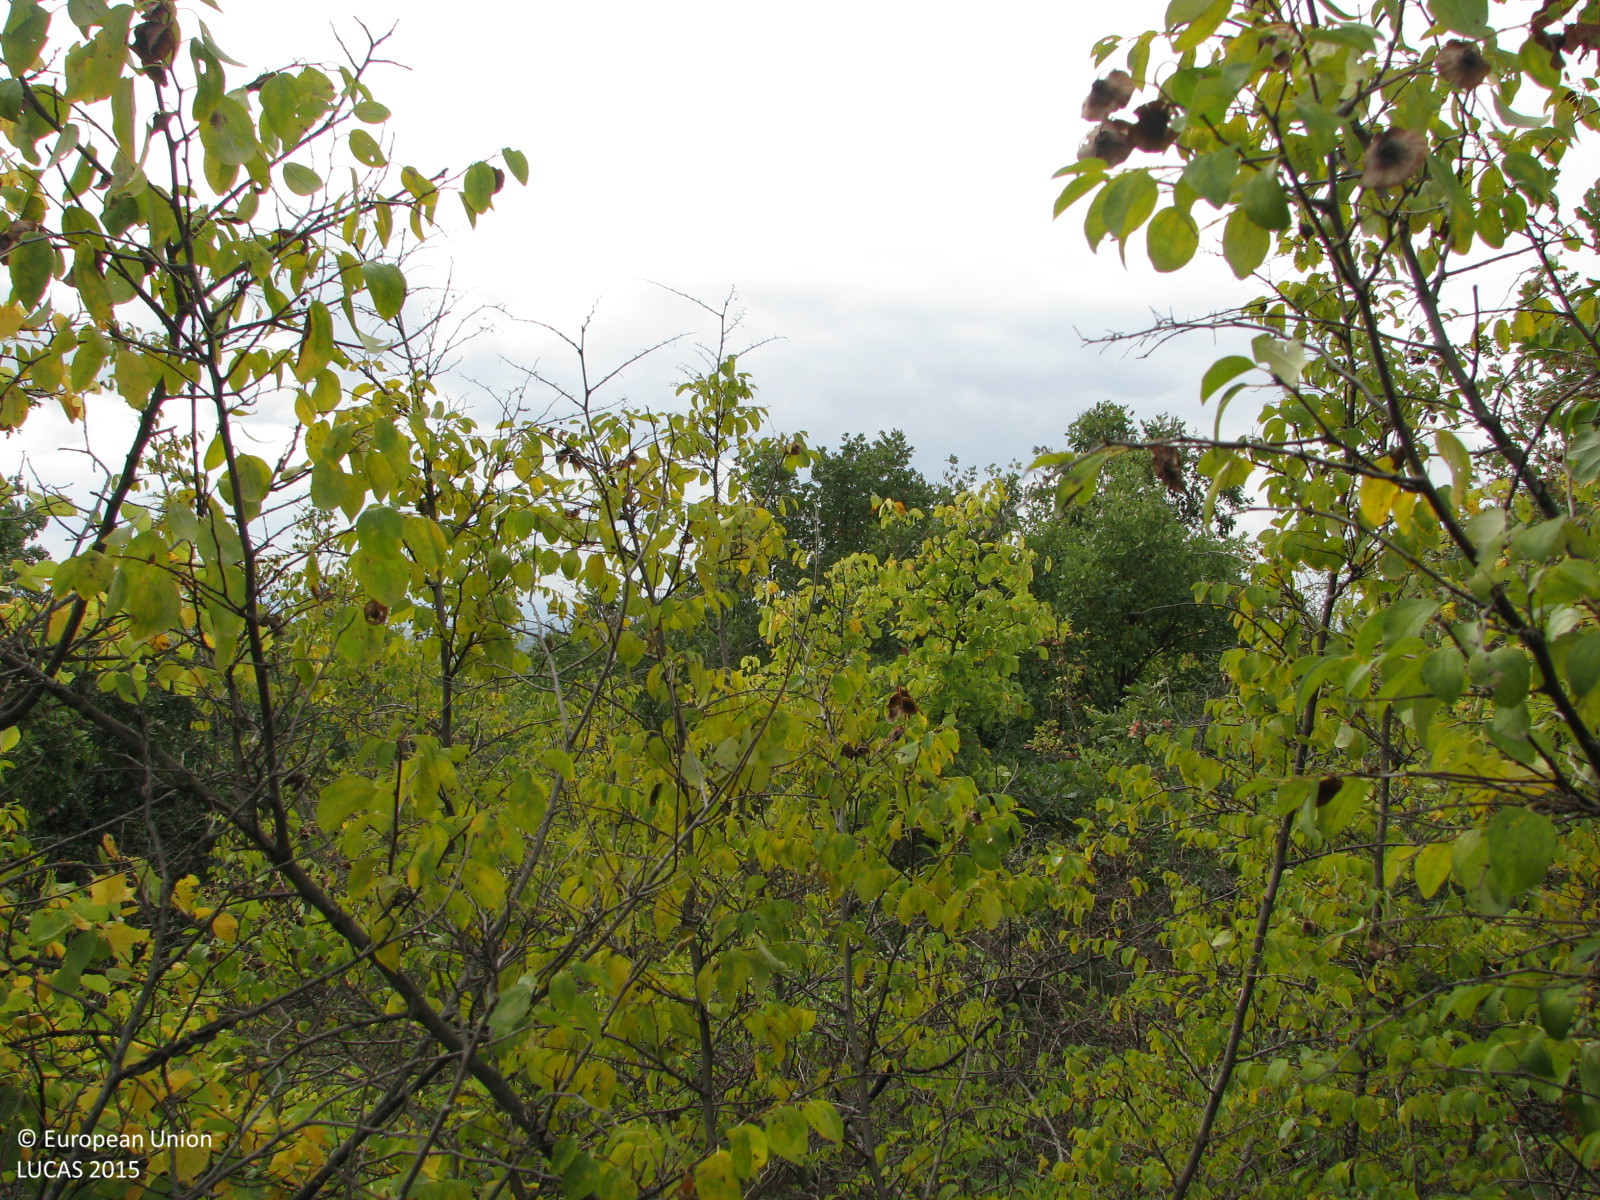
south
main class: Shrubland
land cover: Shrubland with sparse tree cover
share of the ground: > 75 %
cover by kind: shrubs 90 %, broadleaved forest trees 5 %, herbaceous plants 5 %
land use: Semi-natural and natural areas not in use
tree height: < 5 m
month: October
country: BG
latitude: 42.4124
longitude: 26.1598
